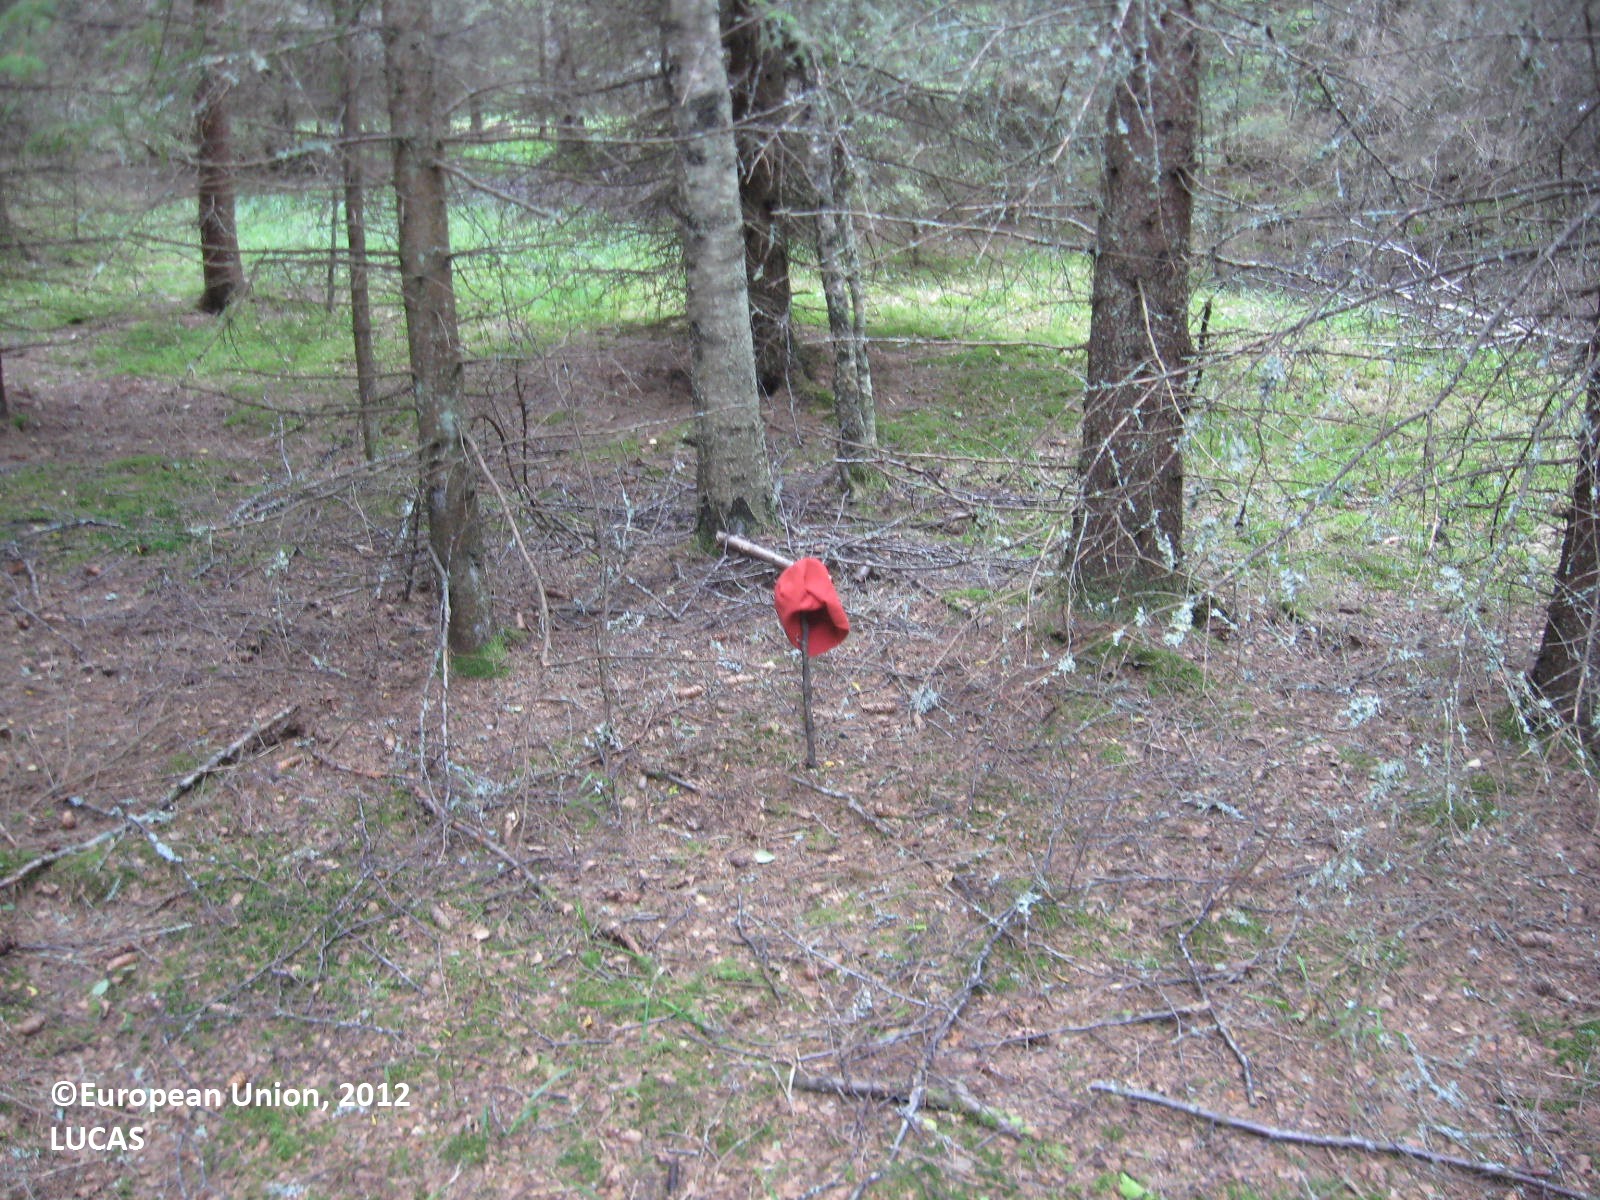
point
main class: Woodland
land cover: Spruce dominated coniferous woodland
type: boreal forest
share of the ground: > 75 %
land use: Forestry
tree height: > 5 m
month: July
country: FI
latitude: 62.0335
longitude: 21.3805
